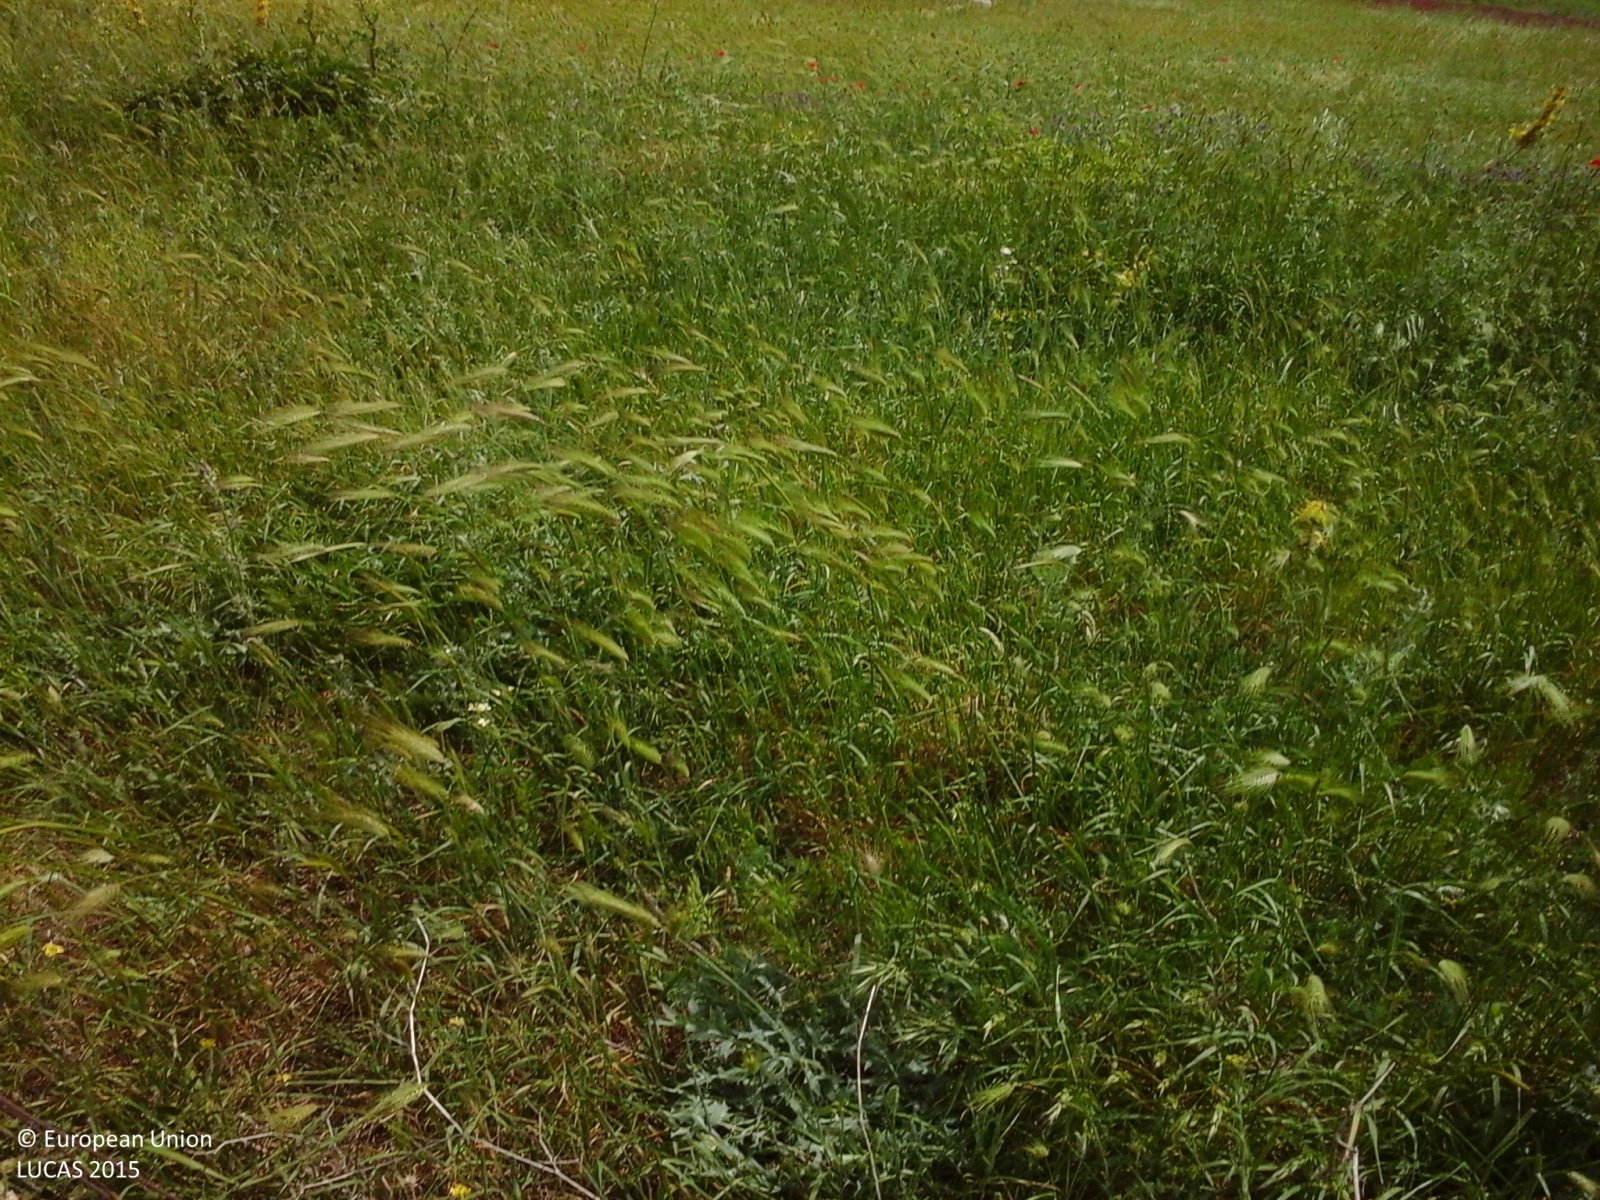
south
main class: Grassland
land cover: Spontaneously vegetated surfaces
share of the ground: > 75 %
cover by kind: herbaceous plants 100 %
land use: Agriculture (excluding fallow land and kitchen gardens)
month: May
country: IT
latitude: 37.6650
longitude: 13.4997
